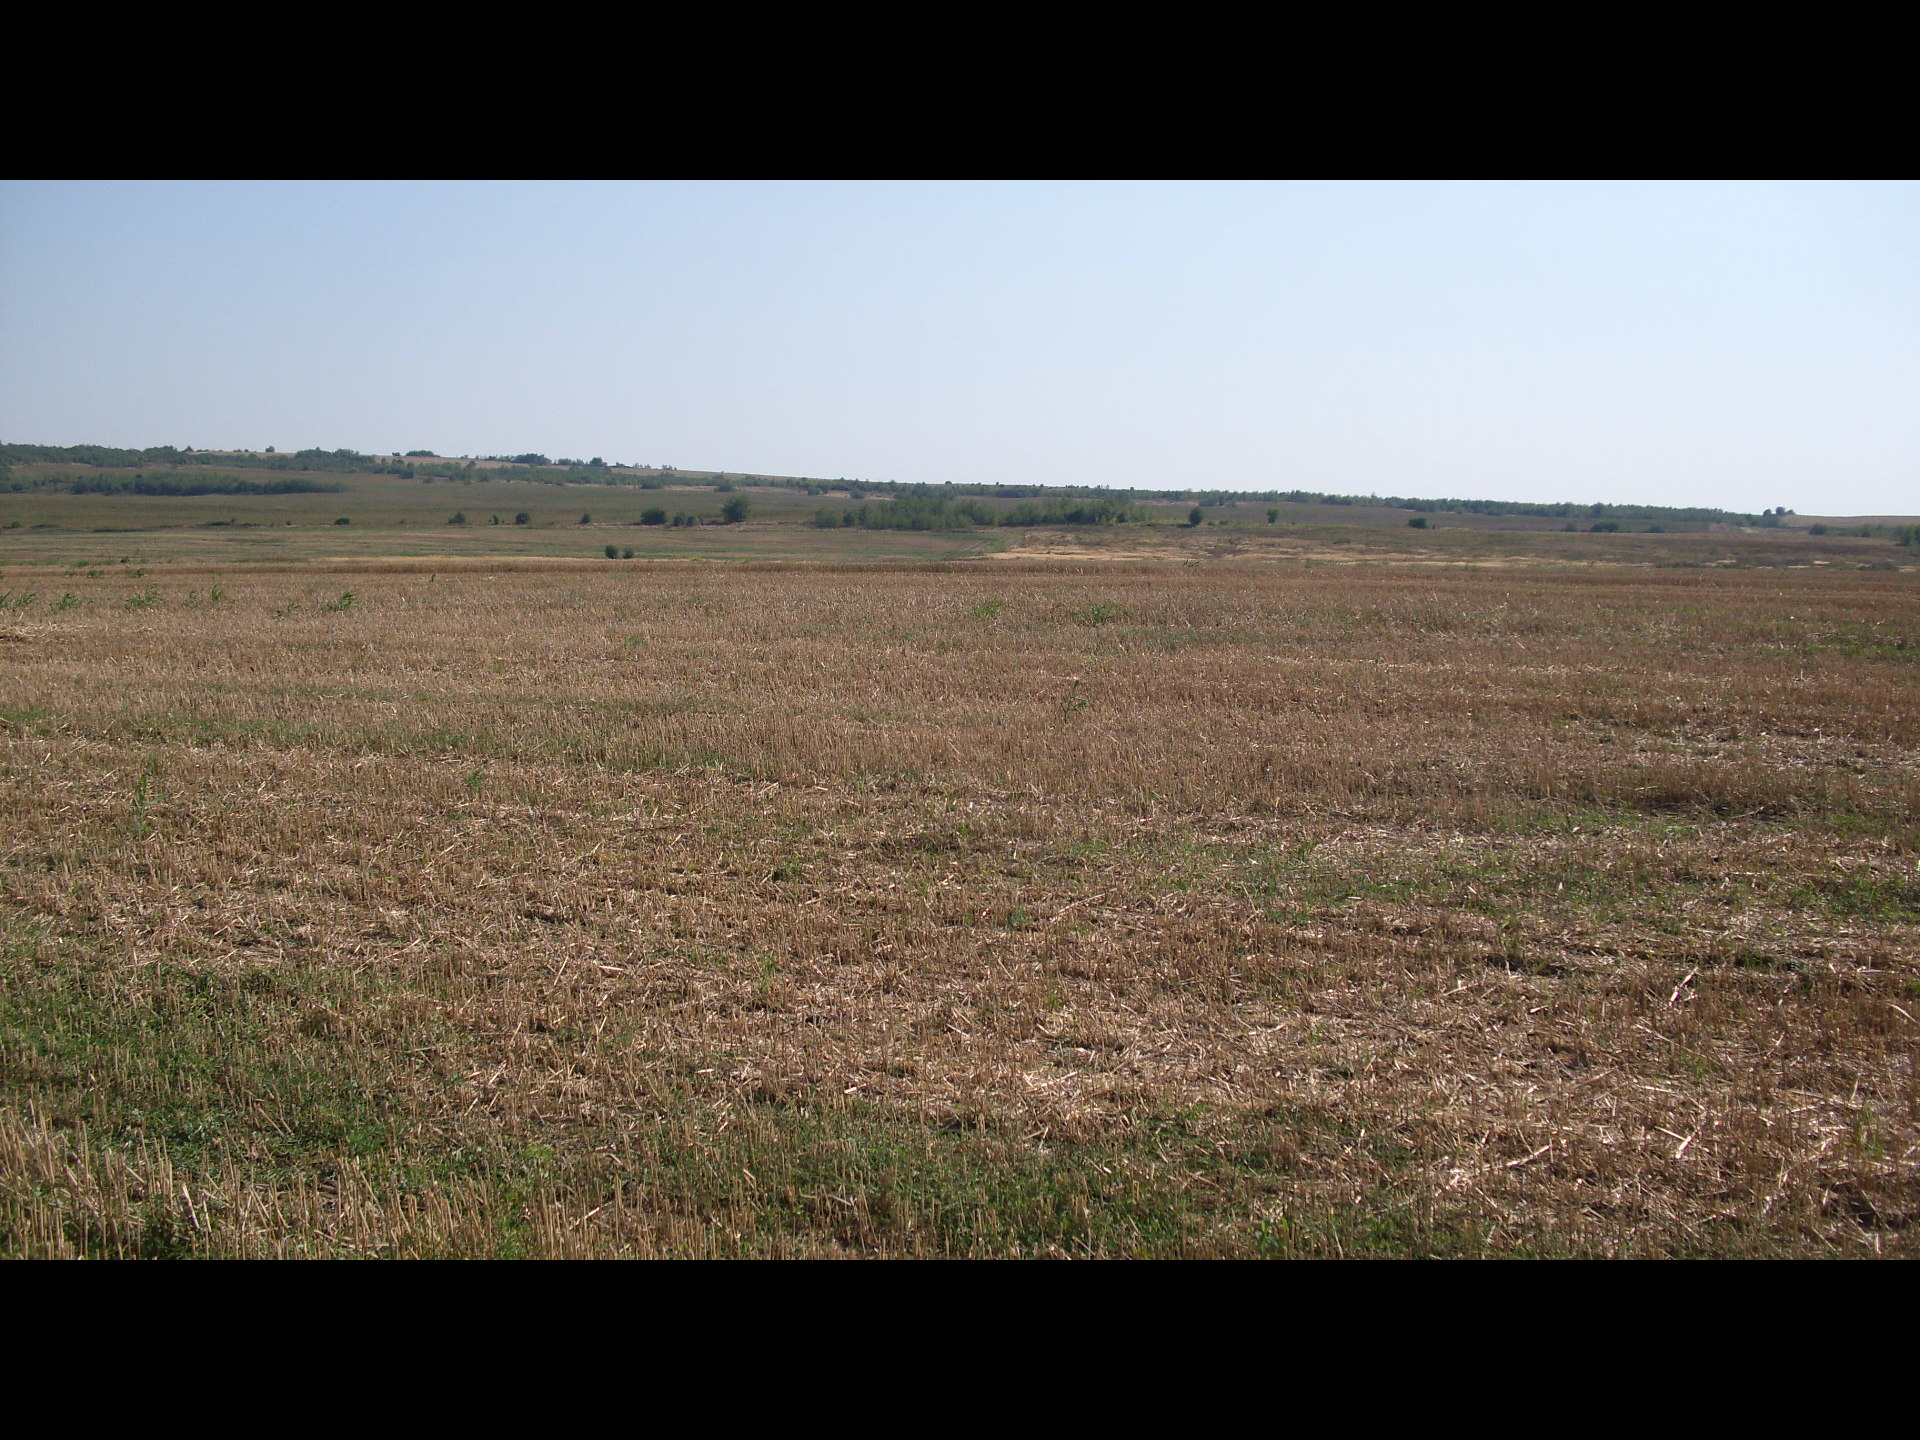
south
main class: Cropland
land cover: Common wheat
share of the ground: 50 - 75 %
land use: Agriculture (excluding fallow land and kitchen gardens)
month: August
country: BG
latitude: 44.1500
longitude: 22.7034
